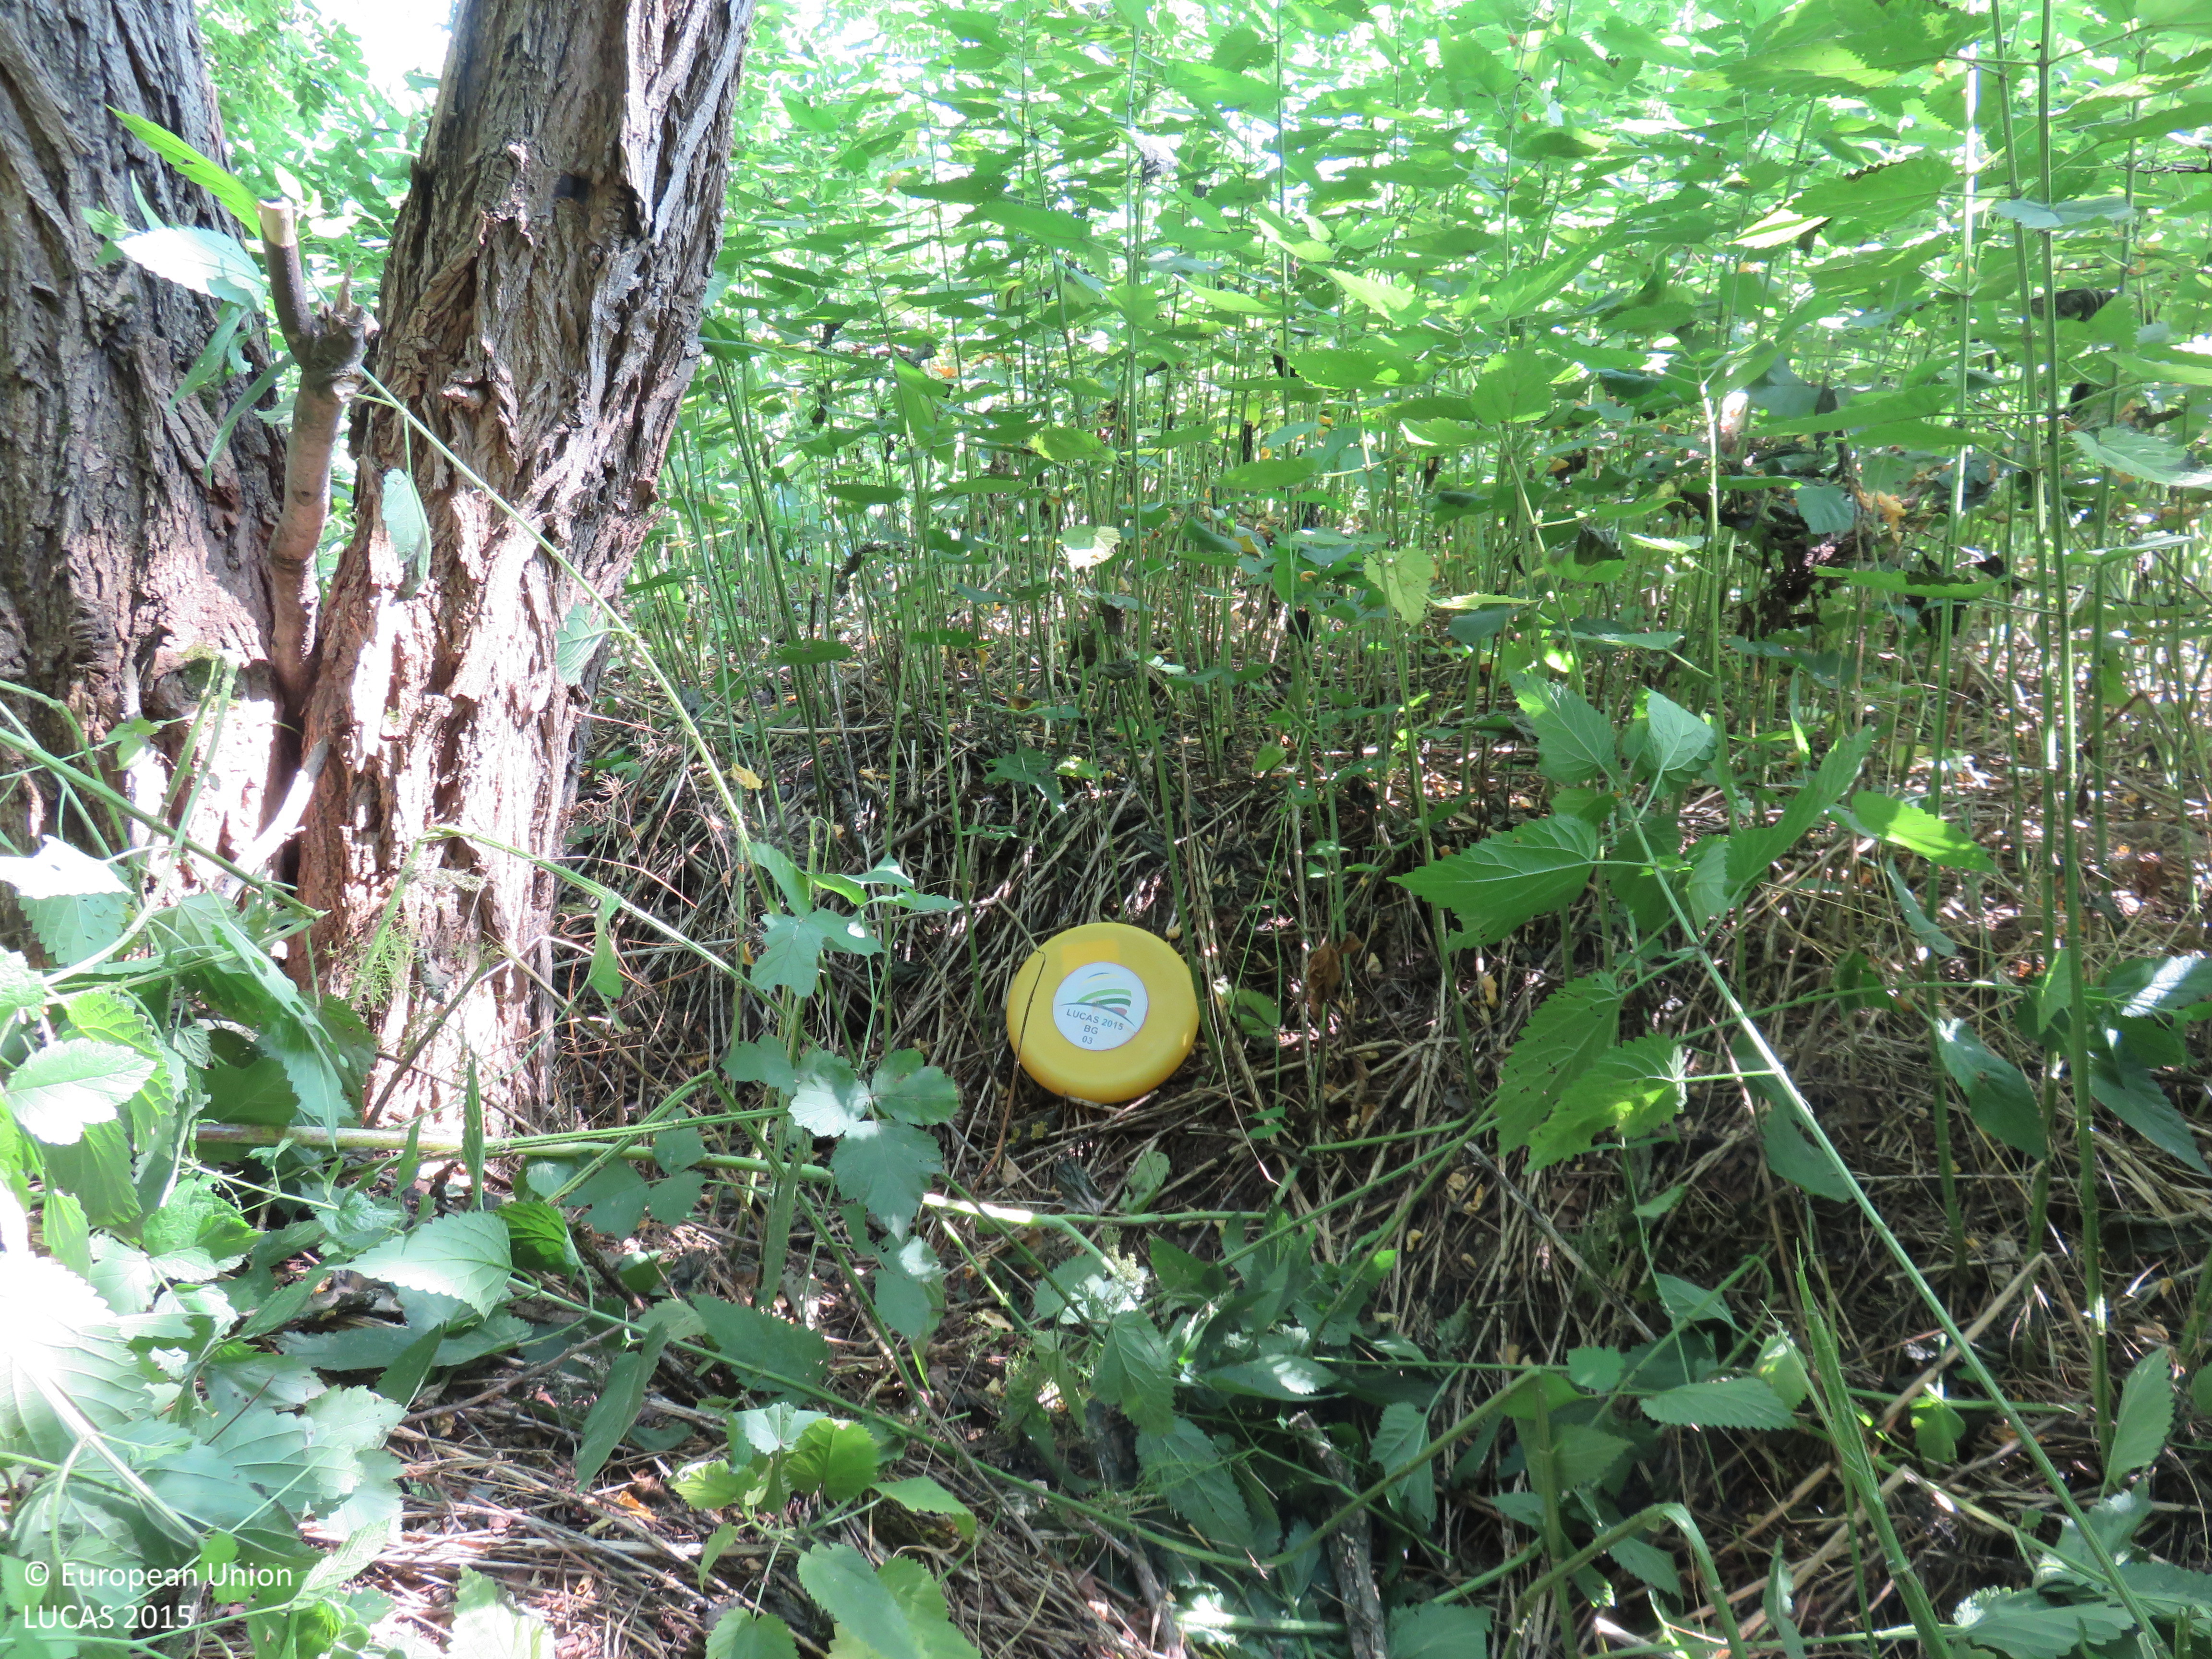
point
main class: Woodland
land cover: Broadleaved woodland
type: mesophytic deciduous forest
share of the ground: > 75 %
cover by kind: broadleaved forest trees 85 %, herbaceous plants 10 %, shrubs 5 %
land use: Forestry
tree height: < 5 m
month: July
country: BG
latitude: 43.5906
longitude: 24.9467
